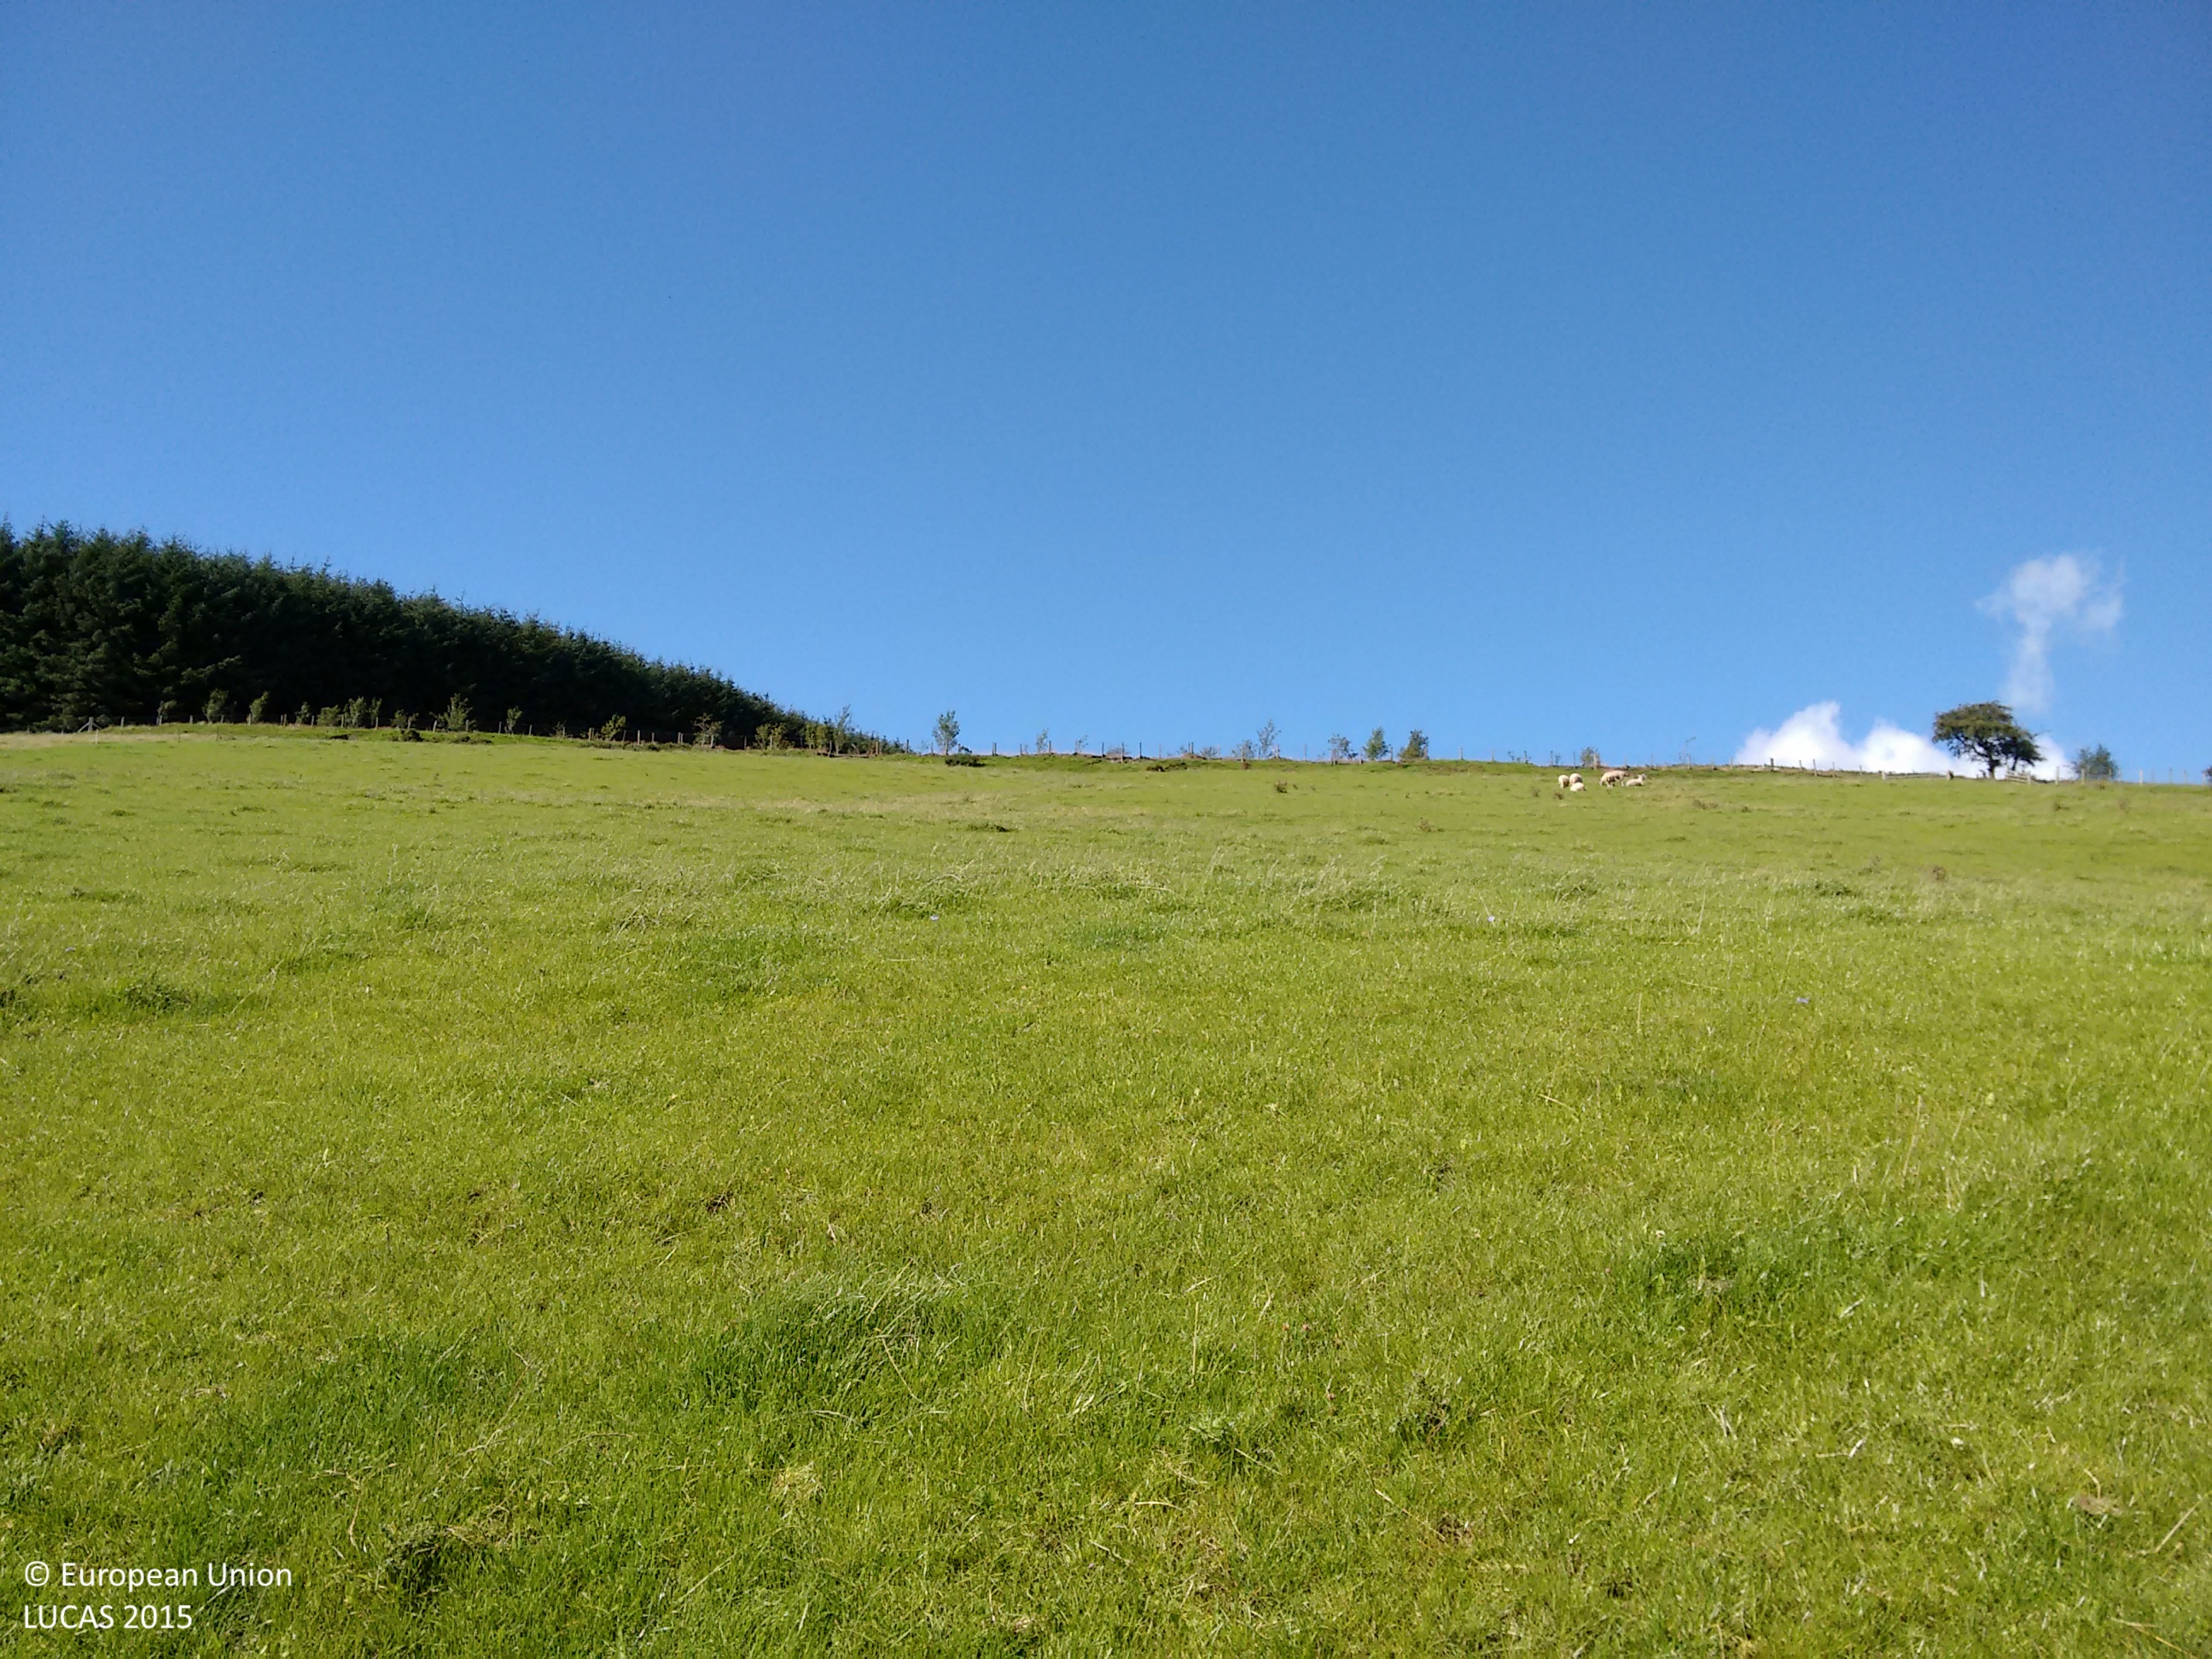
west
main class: Grassland
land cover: Grassland without tree/shrub cover
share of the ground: > 75 %
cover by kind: herbaceous plants 100 %
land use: Agriculture (excluding fallow land and kitchen gardens)
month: August
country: GB
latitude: 53.1315
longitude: -3.5209
